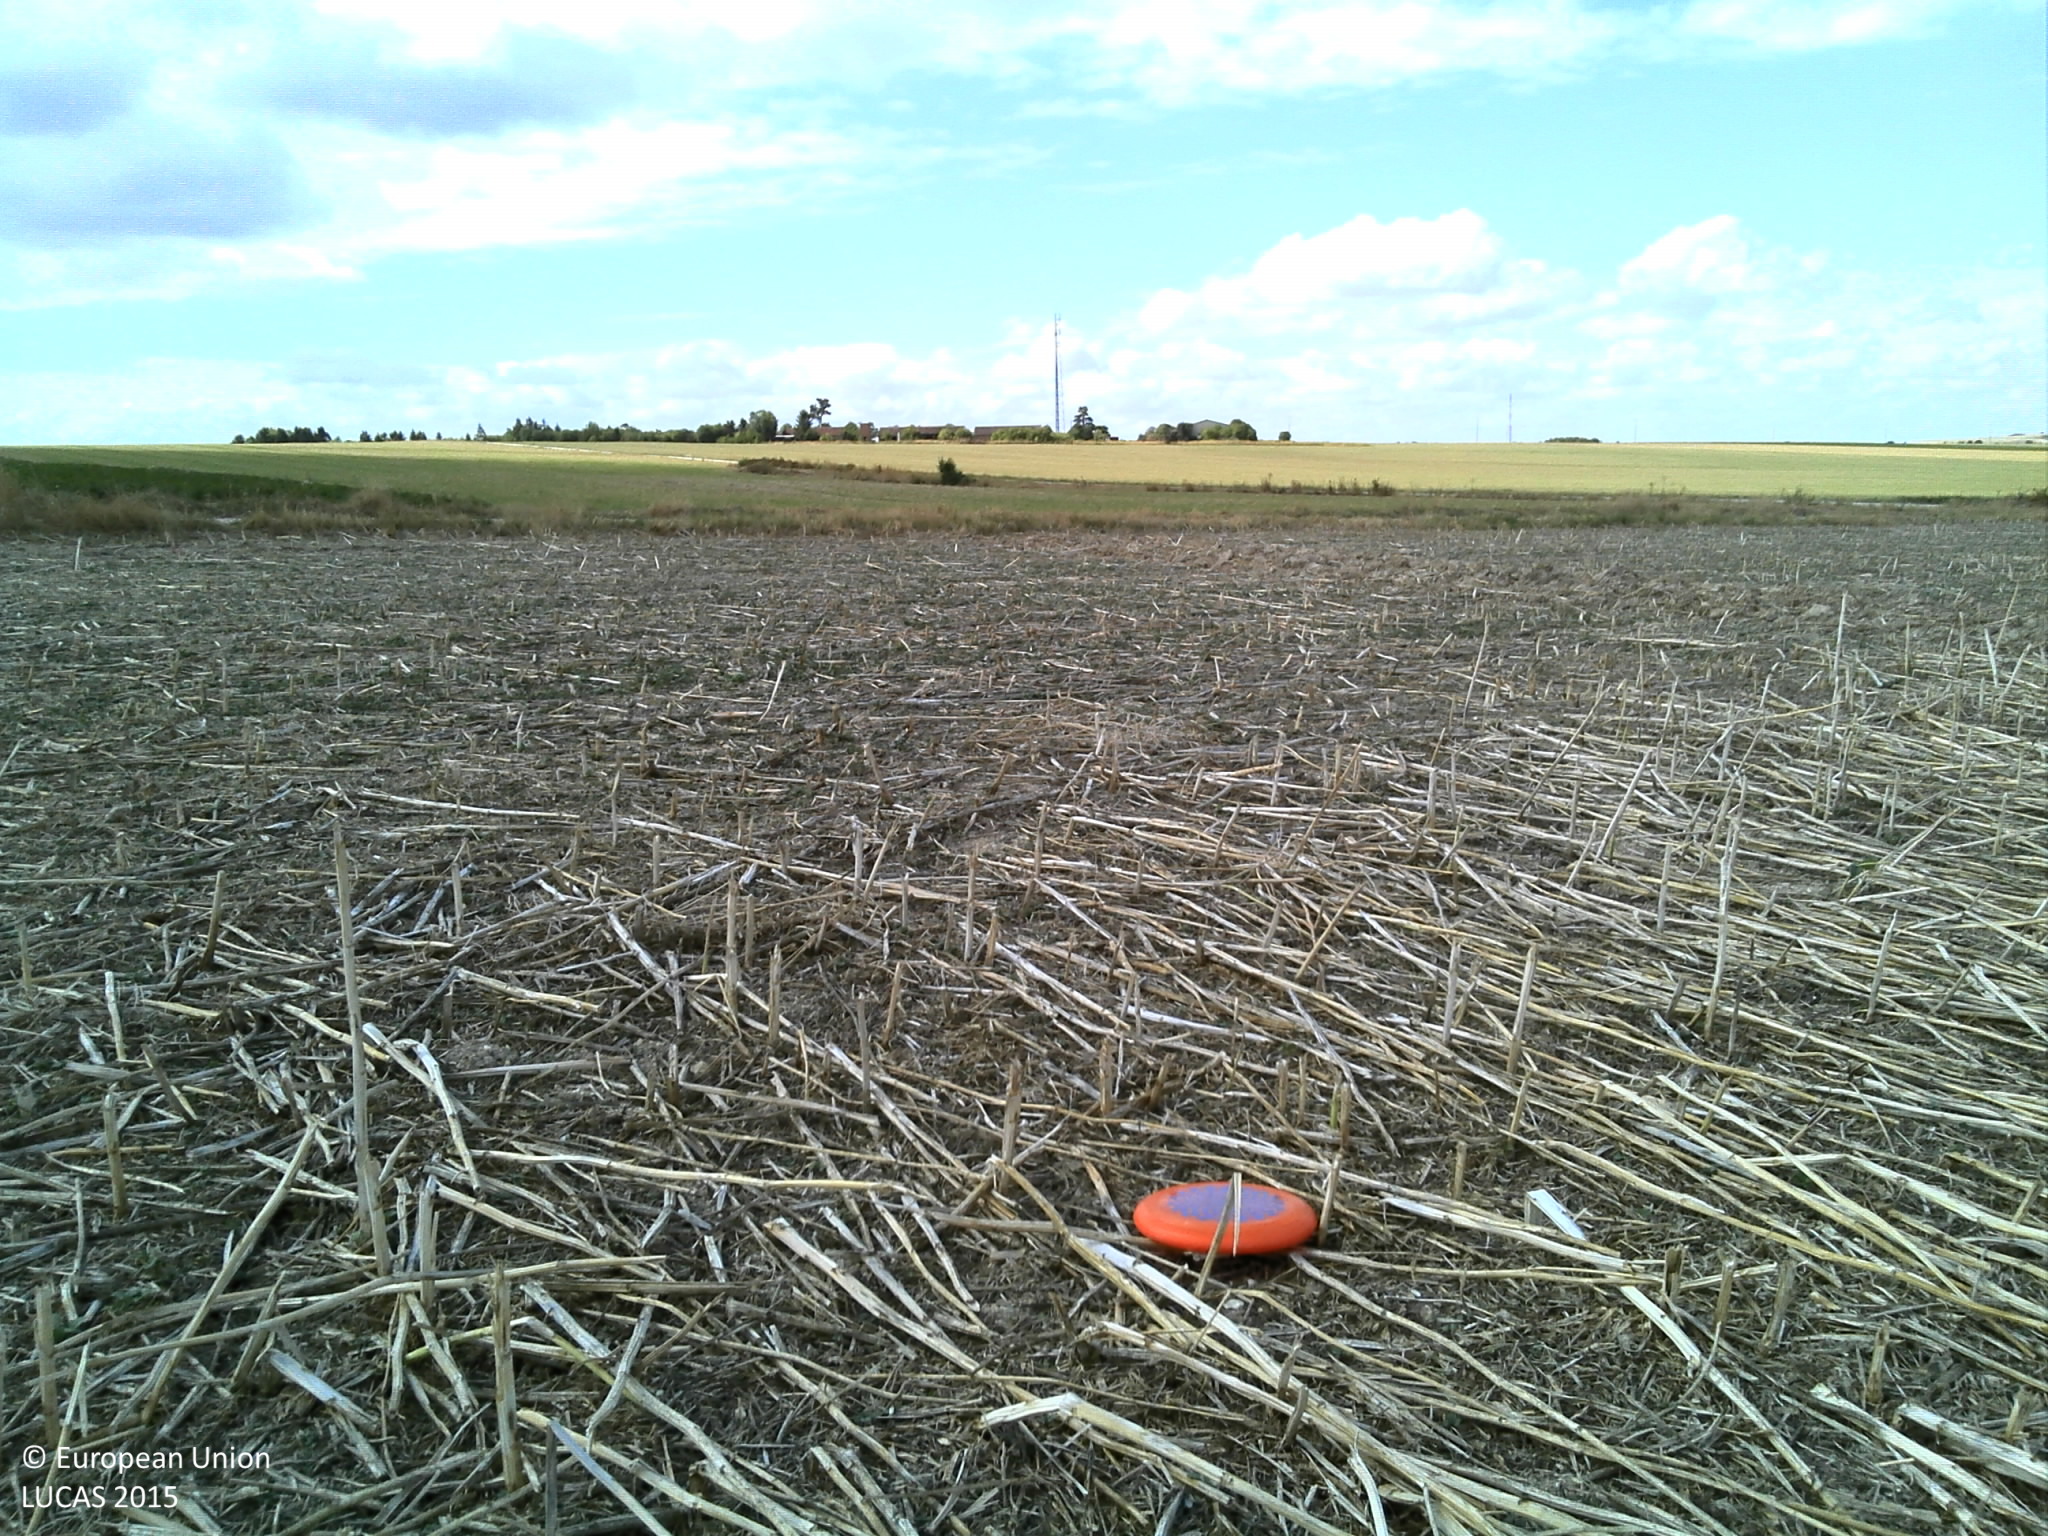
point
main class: Cropland
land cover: Rape and turnip rape
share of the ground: > 75 %
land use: Agriculture (excluding fallow land and kitchen gardens)
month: August
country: FR
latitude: 48.7406
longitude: 4.2441
